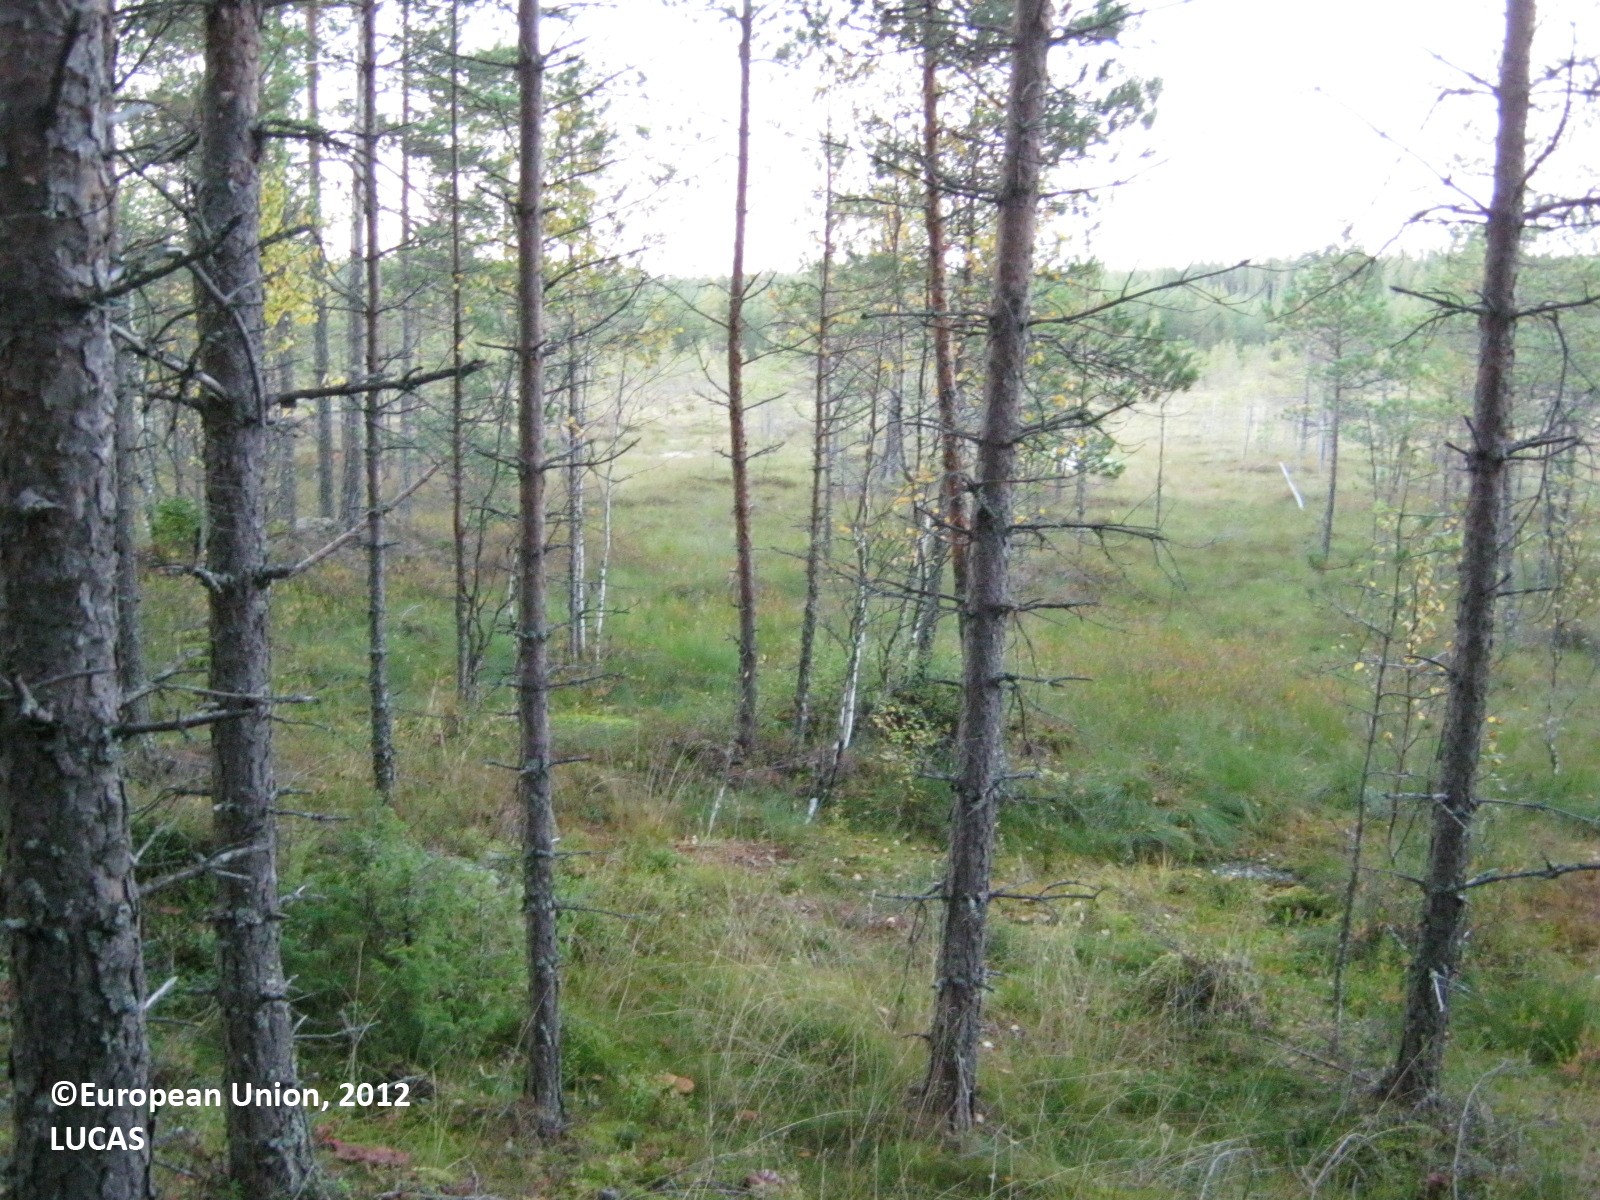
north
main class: Woodland
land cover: Pine dominated coniferous woodland
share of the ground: 50 - 75 %
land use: Forestry
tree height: < 5 m
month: September
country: FI
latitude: 60.8835
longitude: 27.9779
